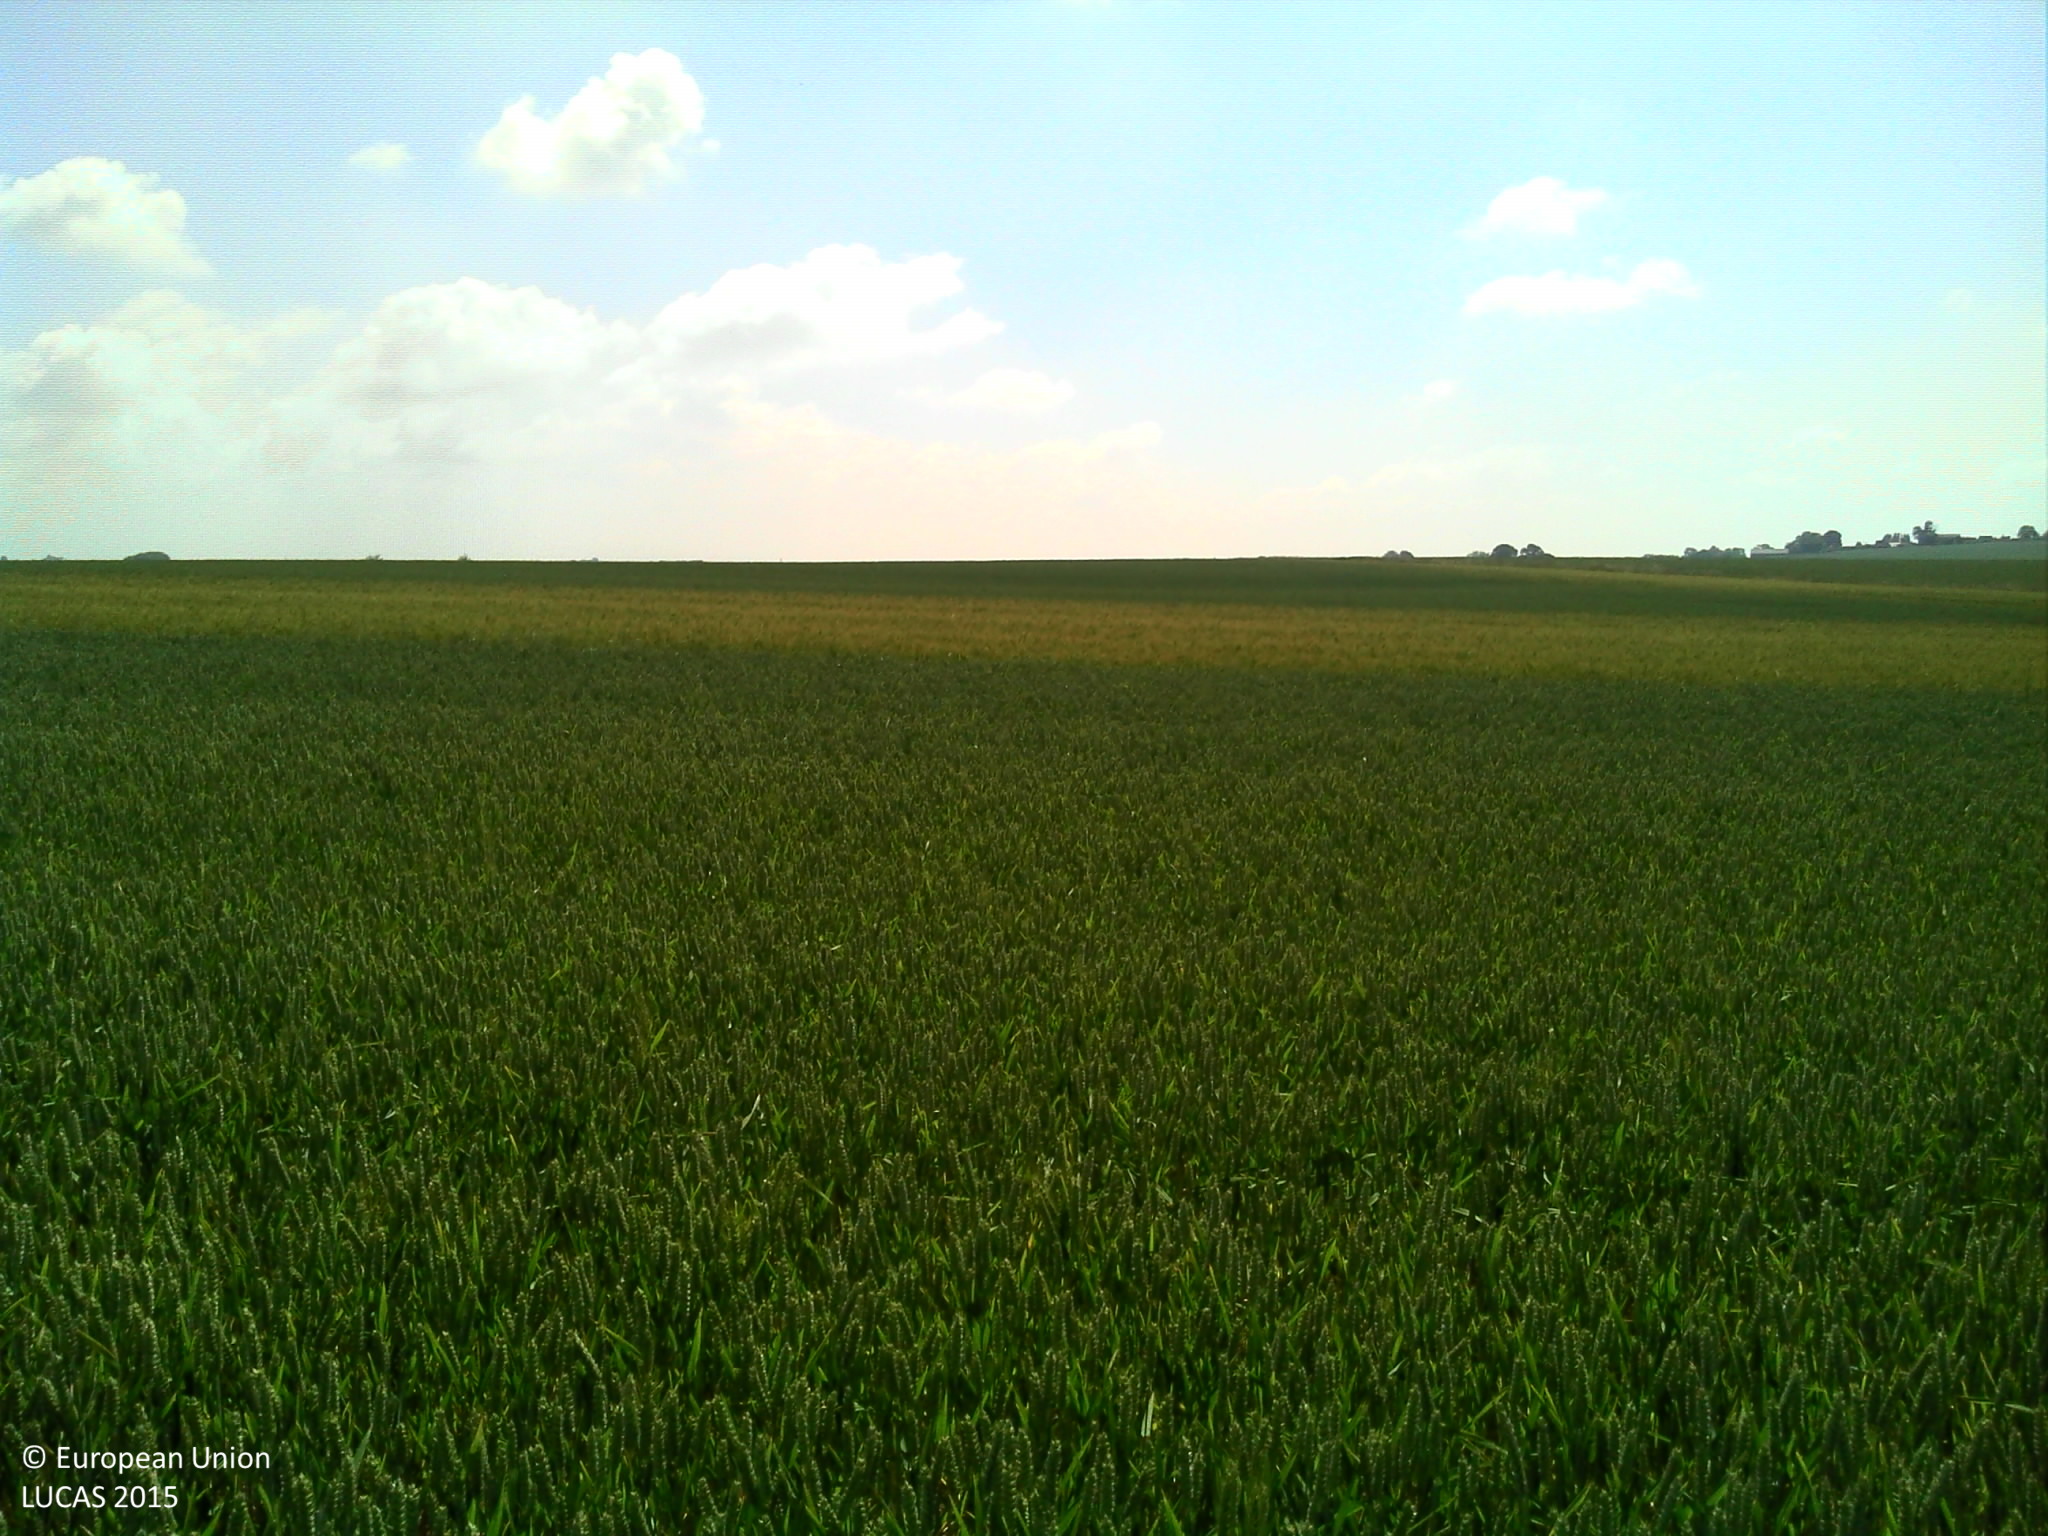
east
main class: Cropland
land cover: Common wheat
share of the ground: > 75 %
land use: Agriculture (excluding fallow land and kitchen gardens)
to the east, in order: Common wheat
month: June
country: FR
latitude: 48.6294
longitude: 0.1070
